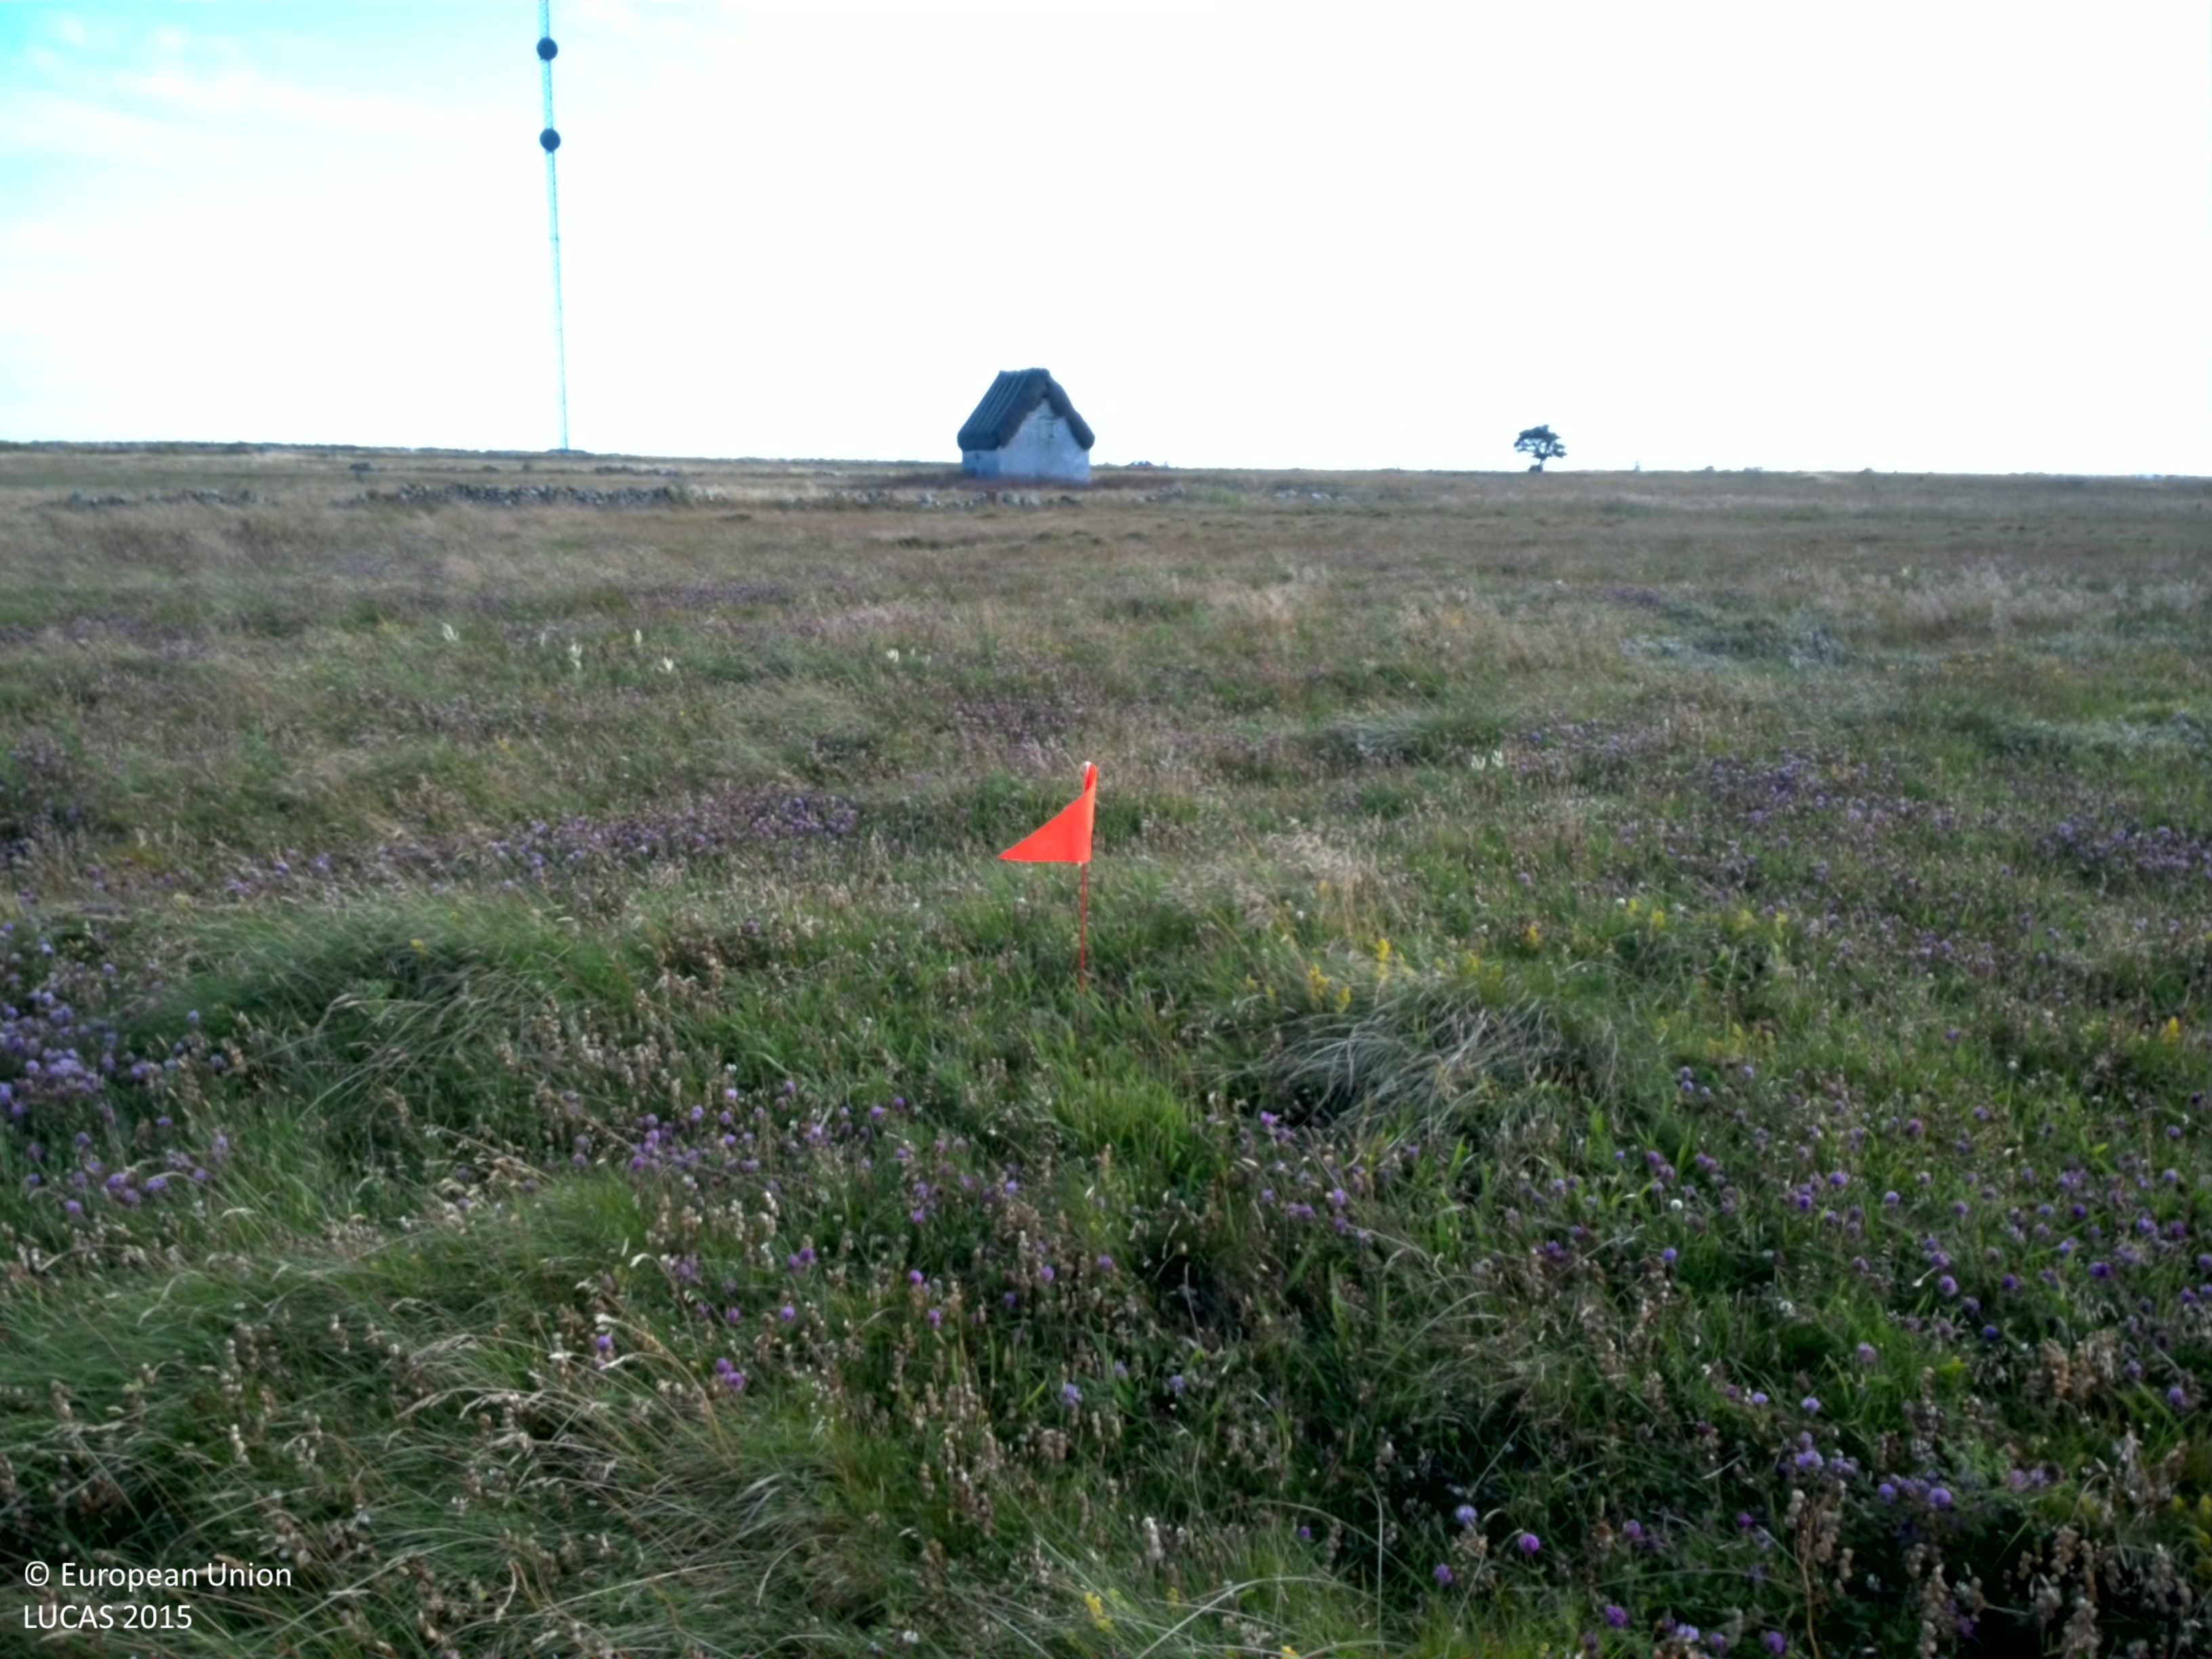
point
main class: Grassland
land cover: Grassland without tree/shrub cover
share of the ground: > 75 %
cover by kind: herbaceous plants 100 %
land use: Semi-natural and natural areas not in use
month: July
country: SE
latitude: 56.9981
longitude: 18.3887
